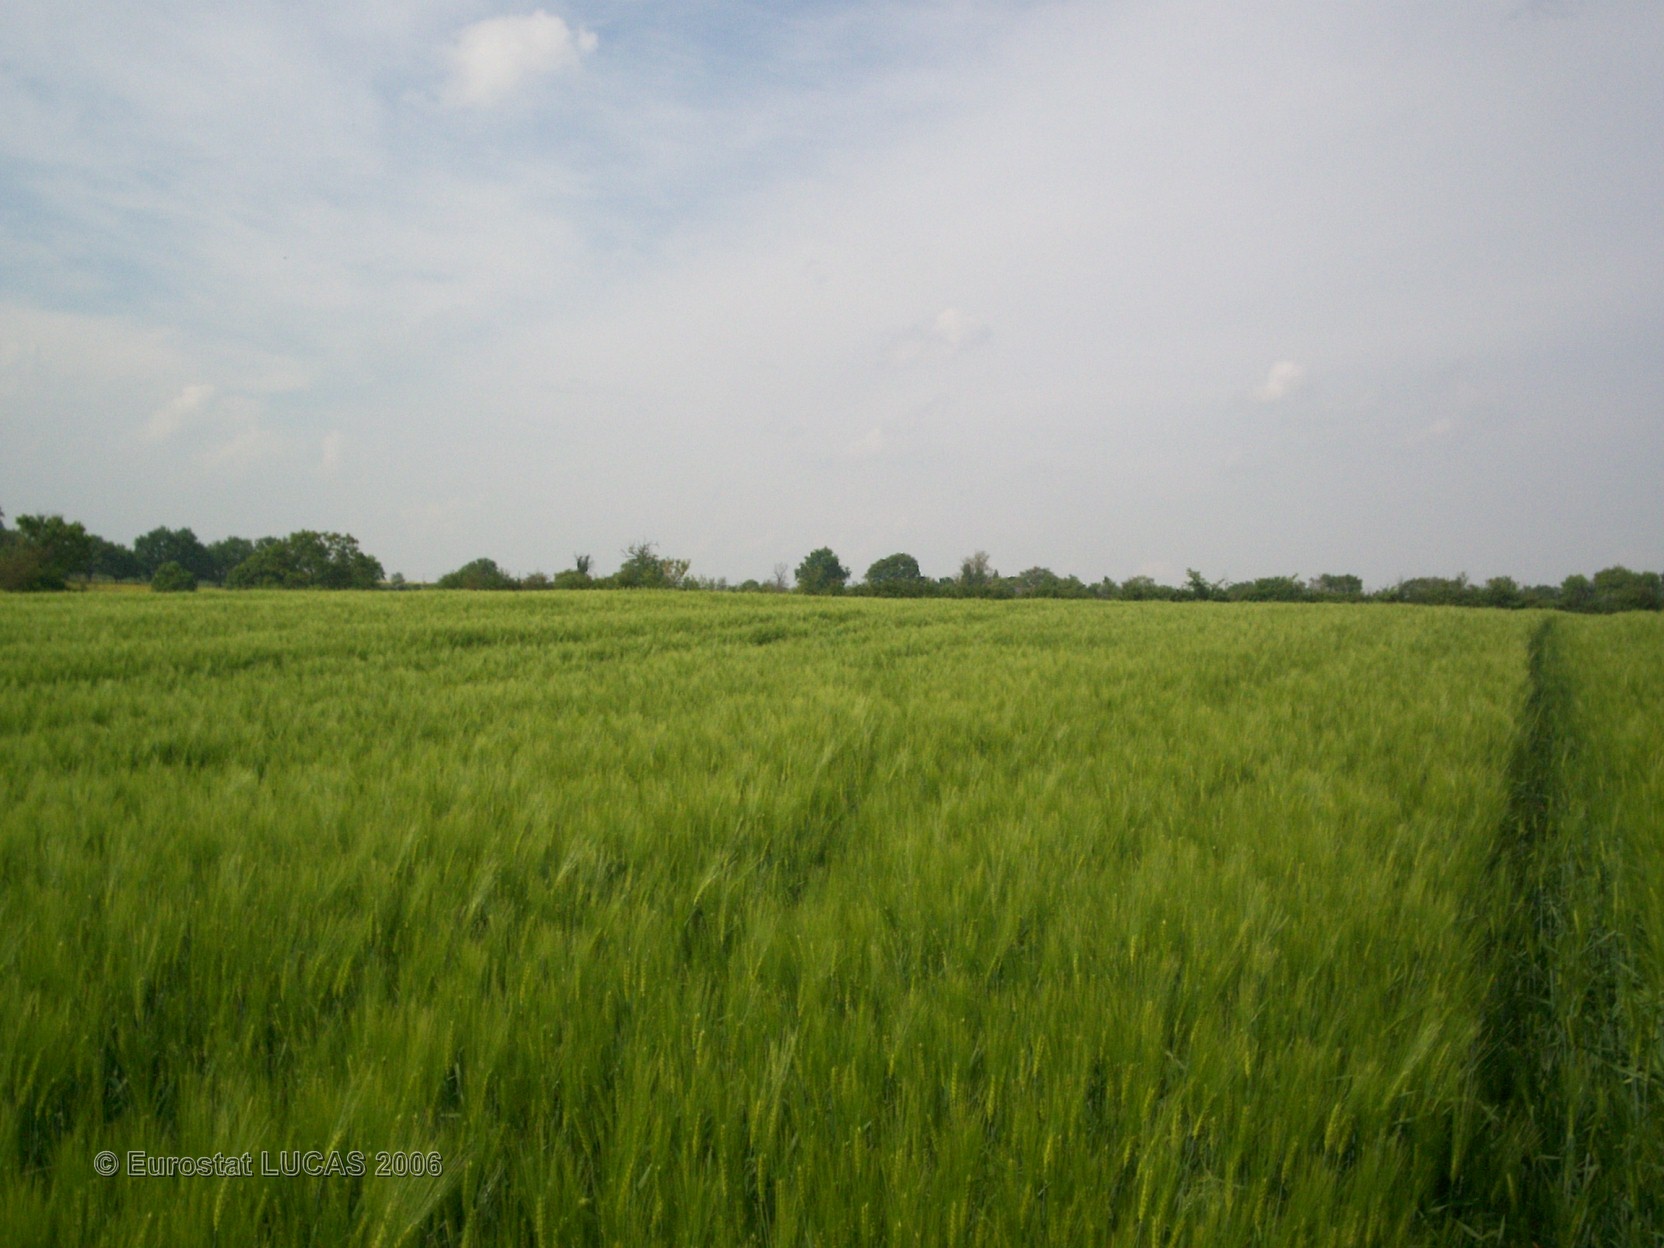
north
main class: Cropland
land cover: Barley
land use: Agriculture (excluding fallow land and kitchen gardens)
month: May
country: FR
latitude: 47.8048
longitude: -0.5682
